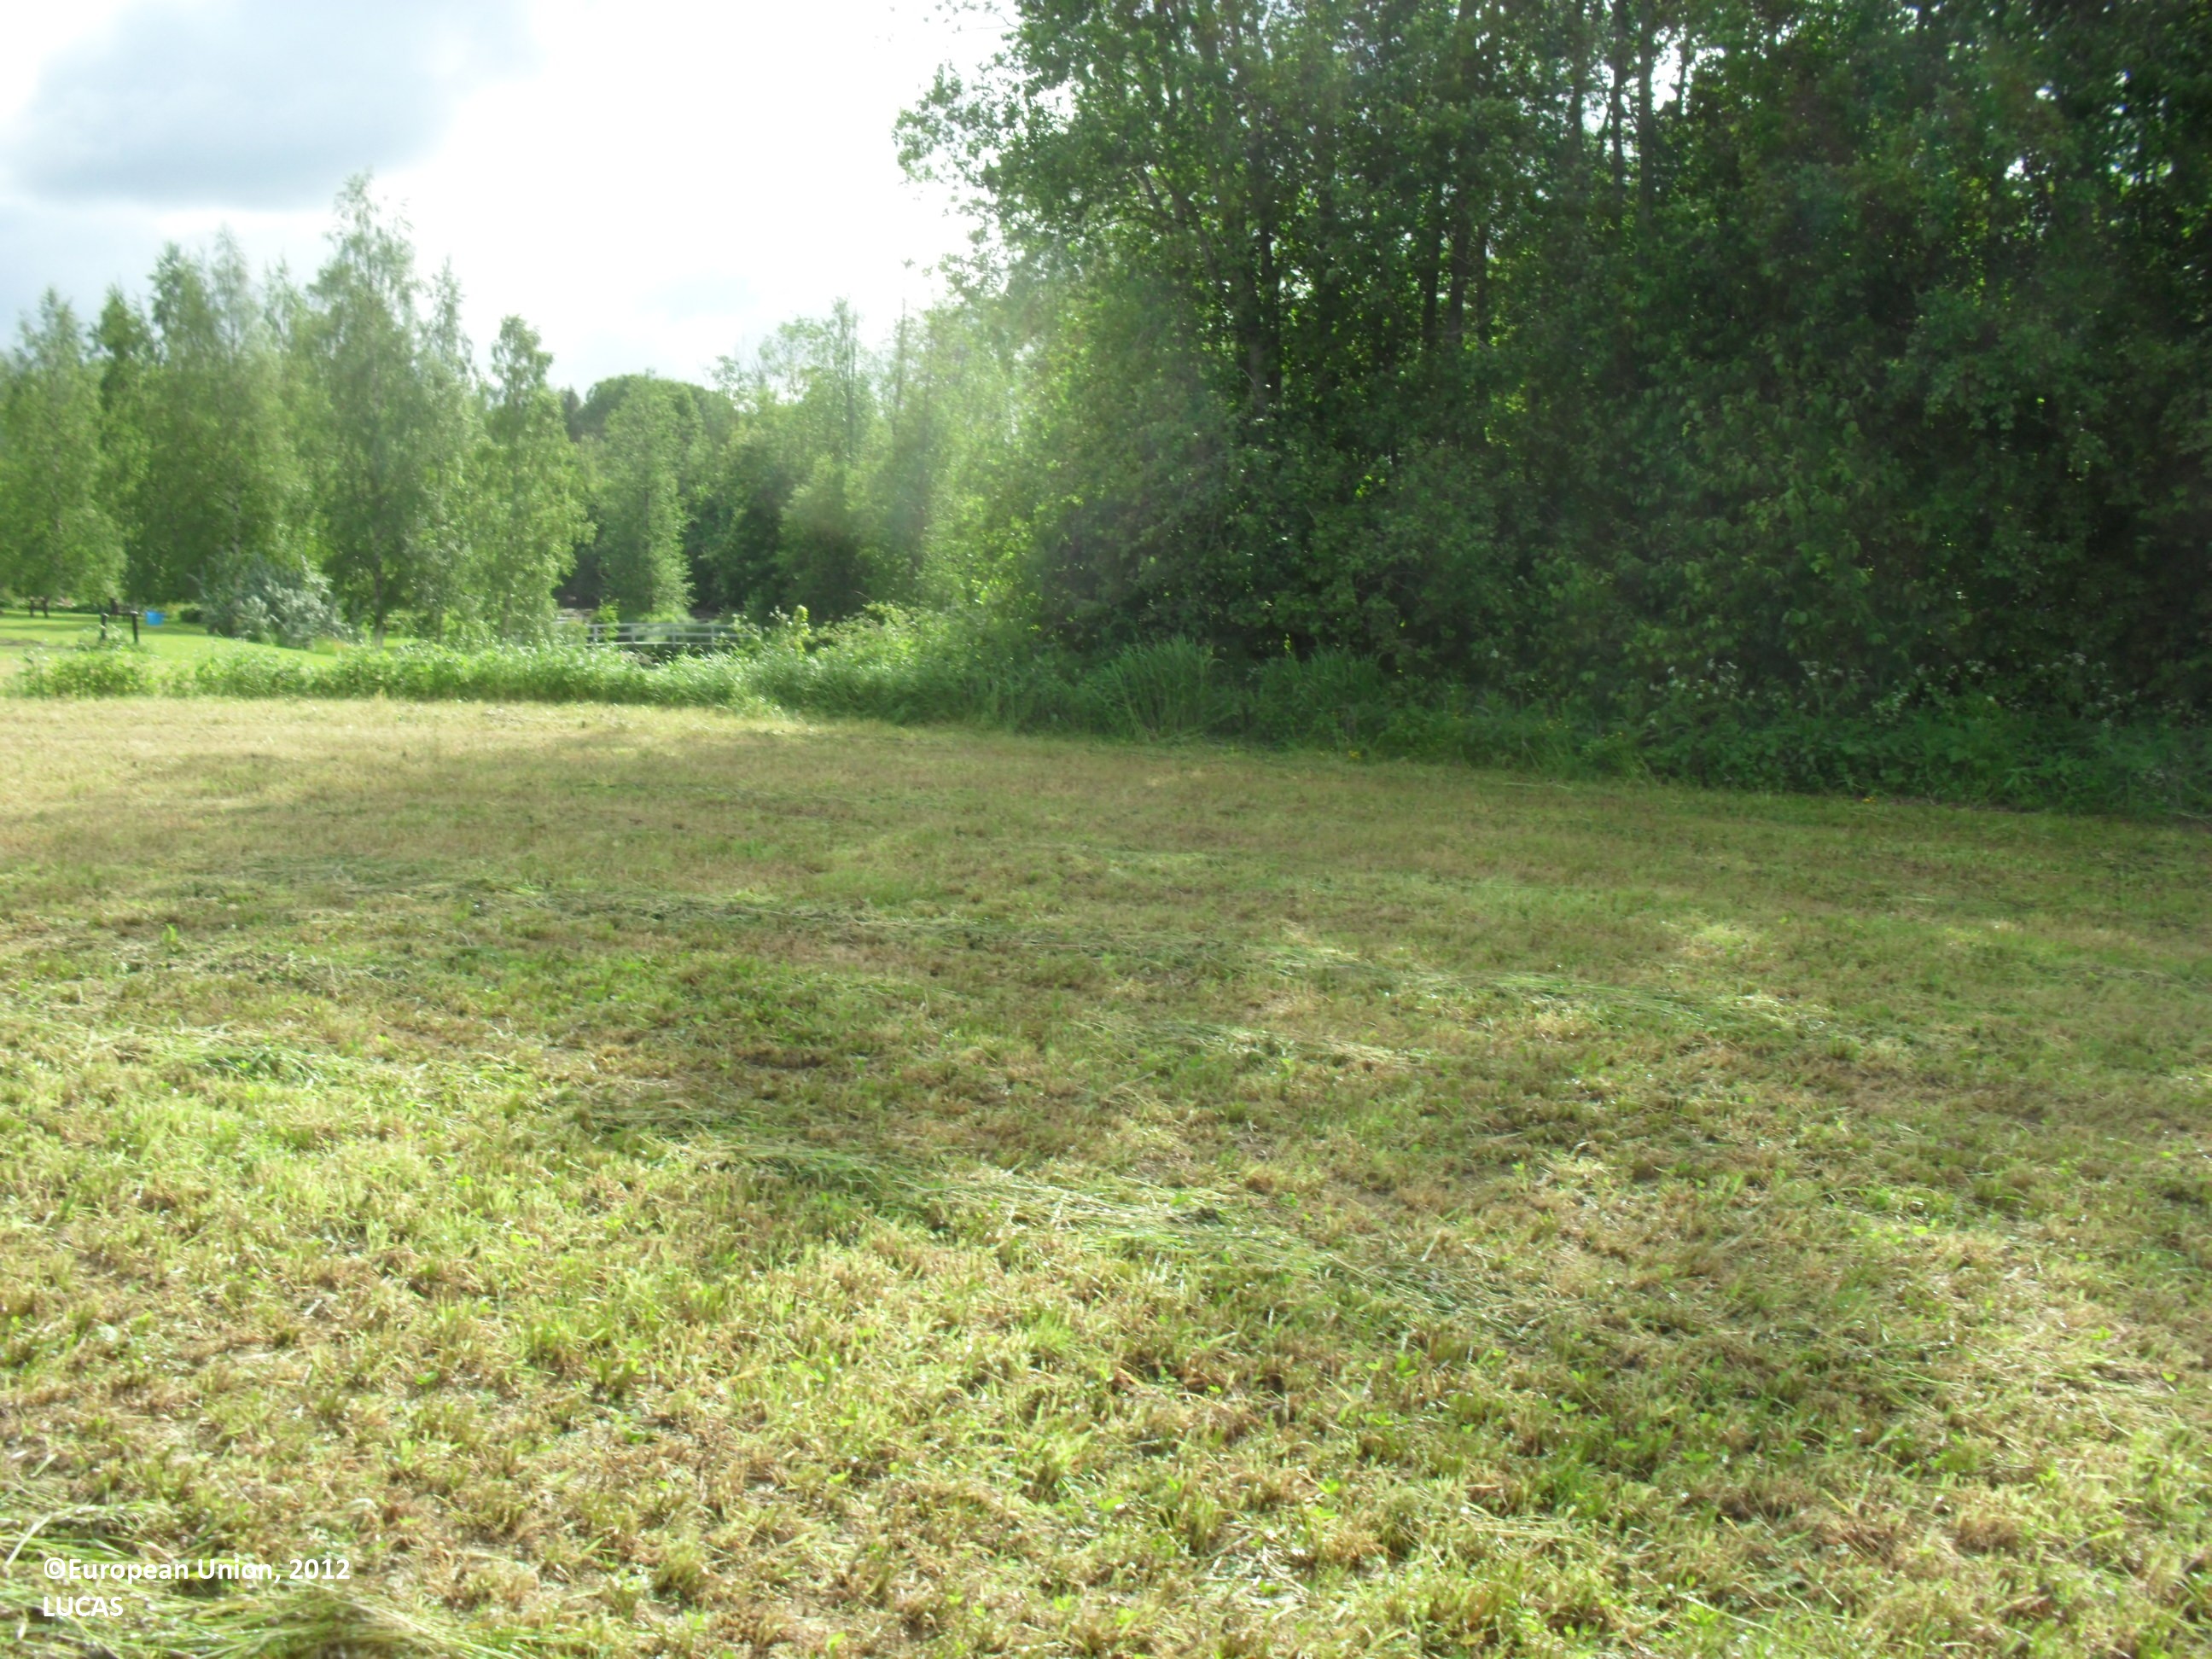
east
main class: Cropland
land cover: Temporary grasslands
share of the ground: 25 - 50 %
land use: Agriculture (excluding fallow land and kitchen gardens)
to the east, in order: Temporary grasslands; Ditches and canals; Temporary grasslands; Grassland without tree/shrub cover; Rivers and streams; Grassland with sparse tree/shrub cover; Rivers and streams; Other mixed woodland; Arable land (only in case pi); Ditches and canals; Arable land (only in case pi)
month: June
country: FI
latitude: 63.1274
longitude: 23.2081
